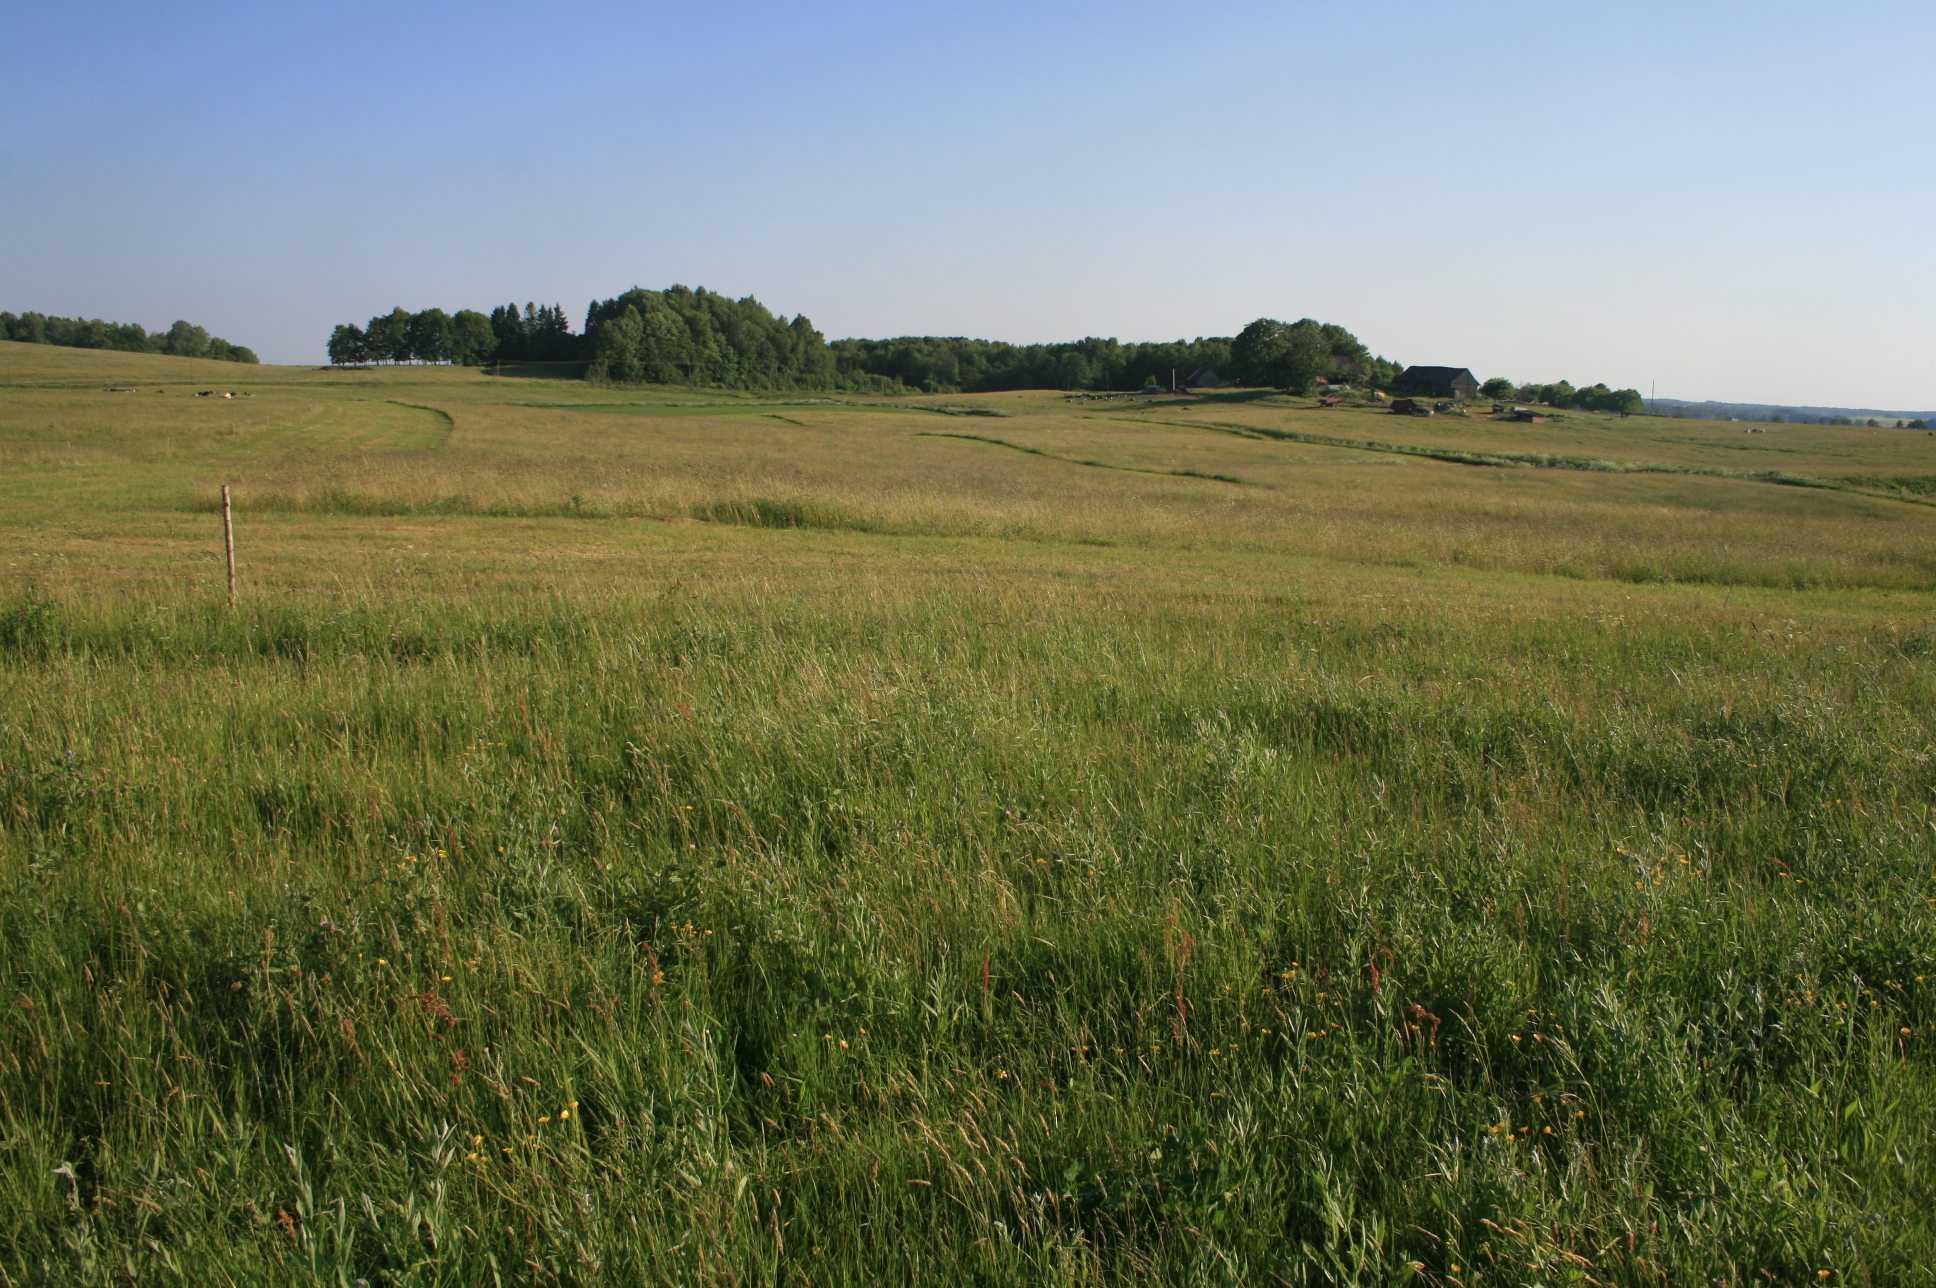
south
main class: Grassland
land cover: Grassland without tree/shrub cover
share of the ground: > 75 %
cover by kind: herbaceous plants 100 %
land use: Agriculture (excluding fallow land and kitchen gardens)
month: June
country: LT
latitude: 55.6739
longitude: 22.2201
